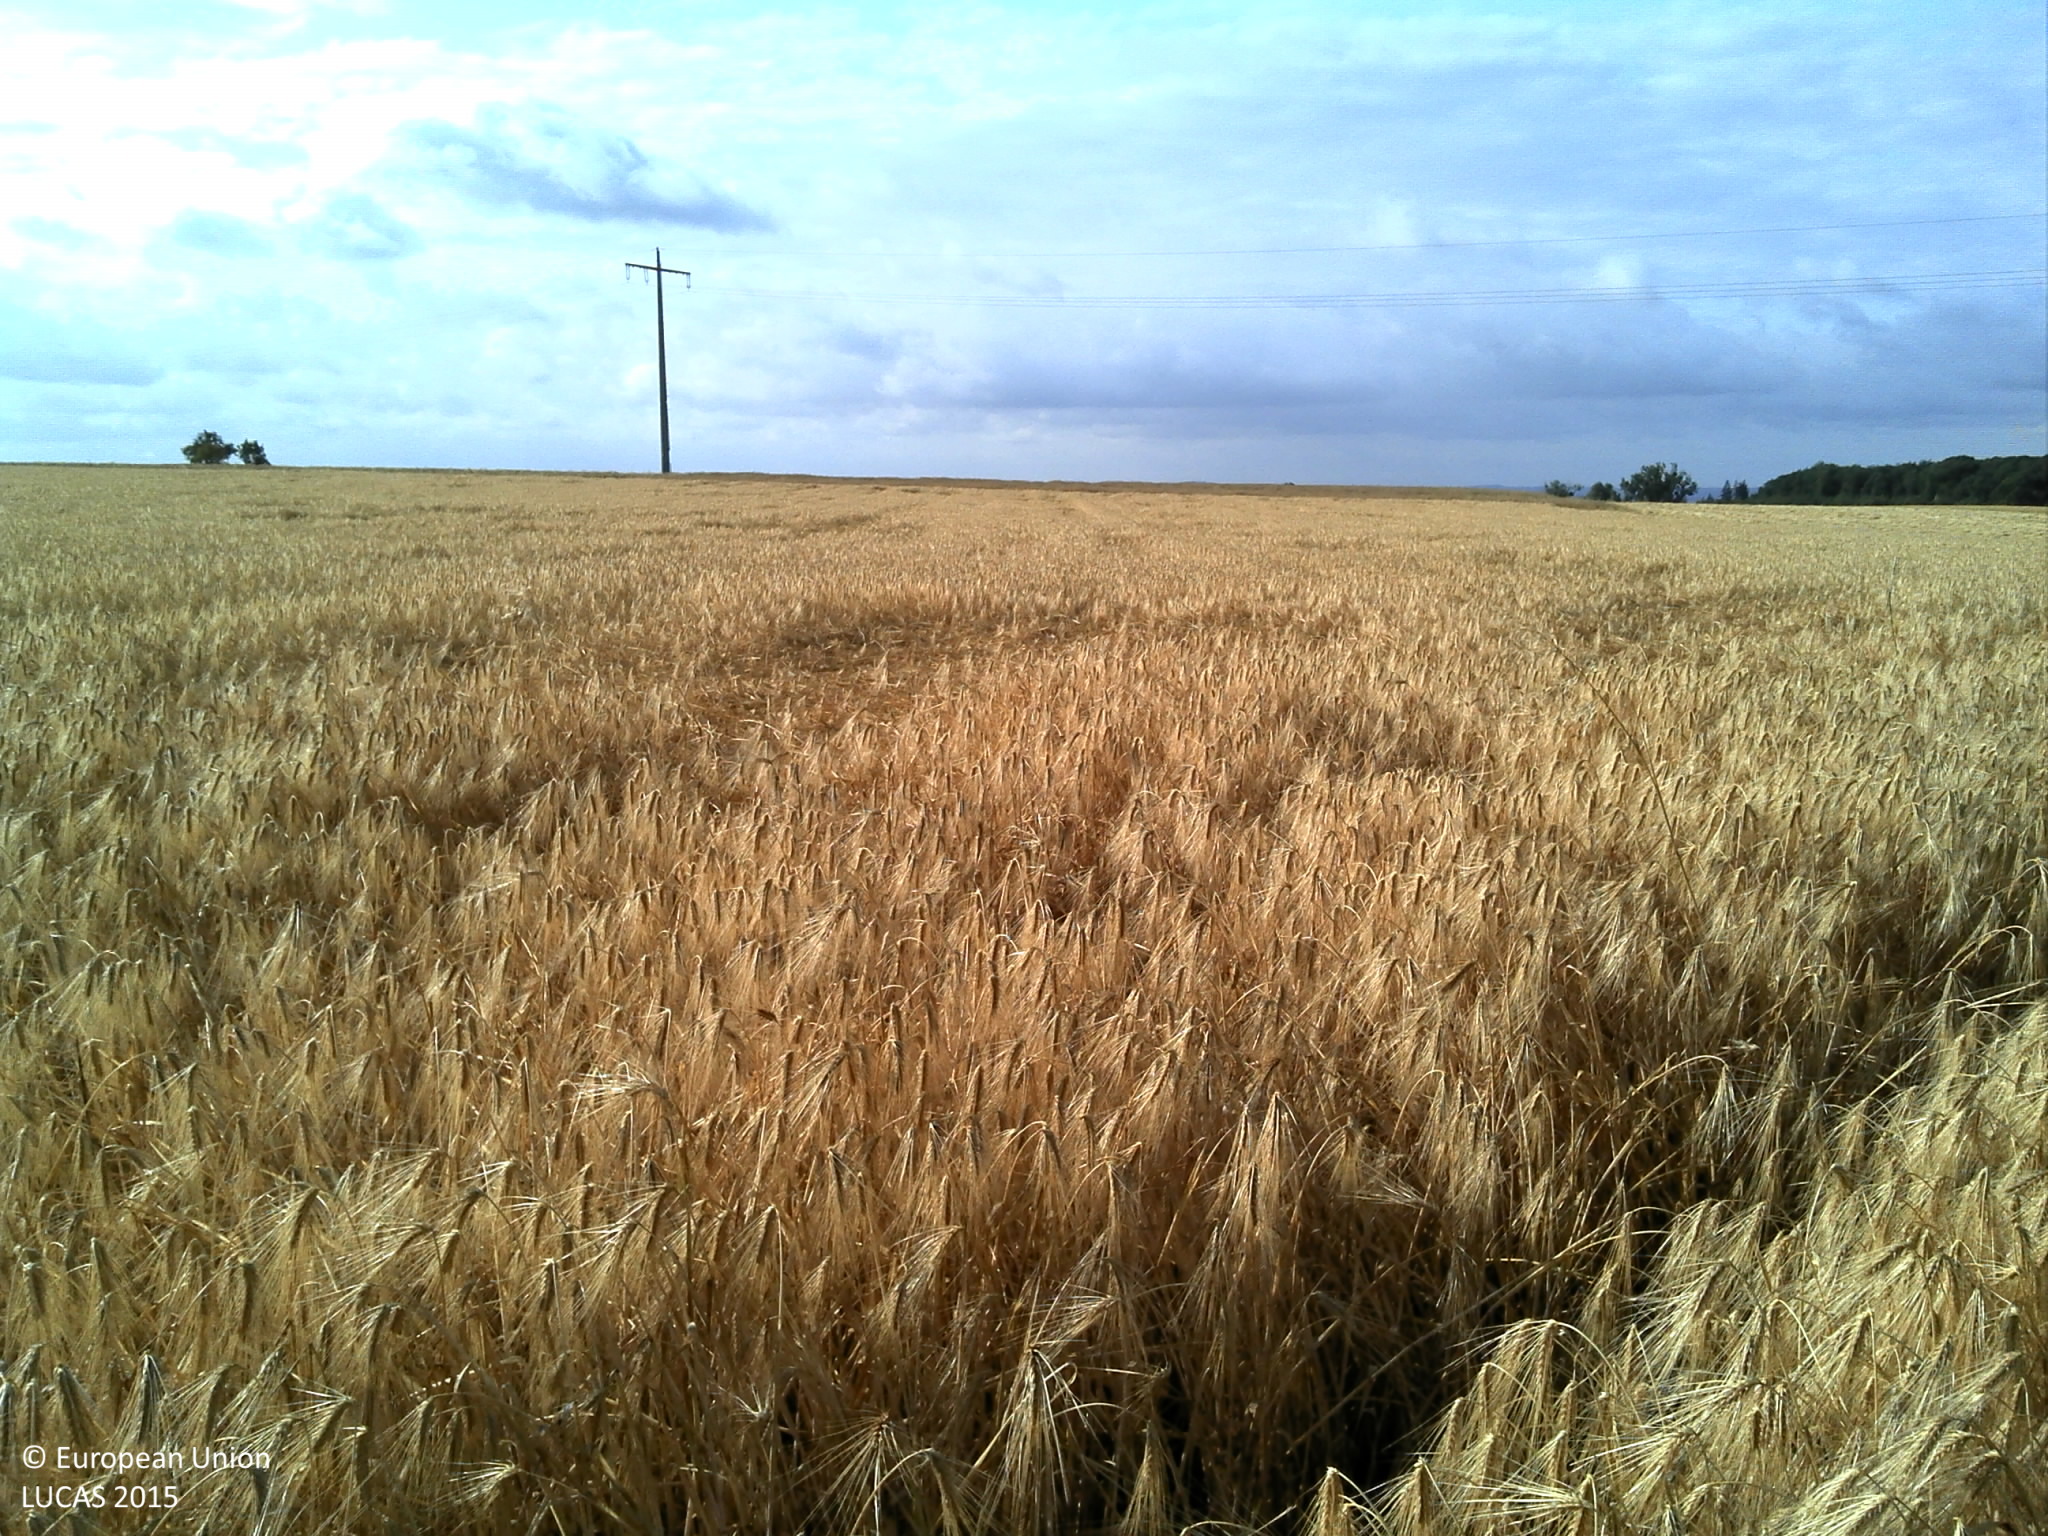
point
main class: Cropland
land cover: Barley
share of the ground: > 75 %
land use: Agriculture (excluding fallow land and kitchen gardens)
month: July
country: LU
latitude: 49.5296
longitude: 6.2830
